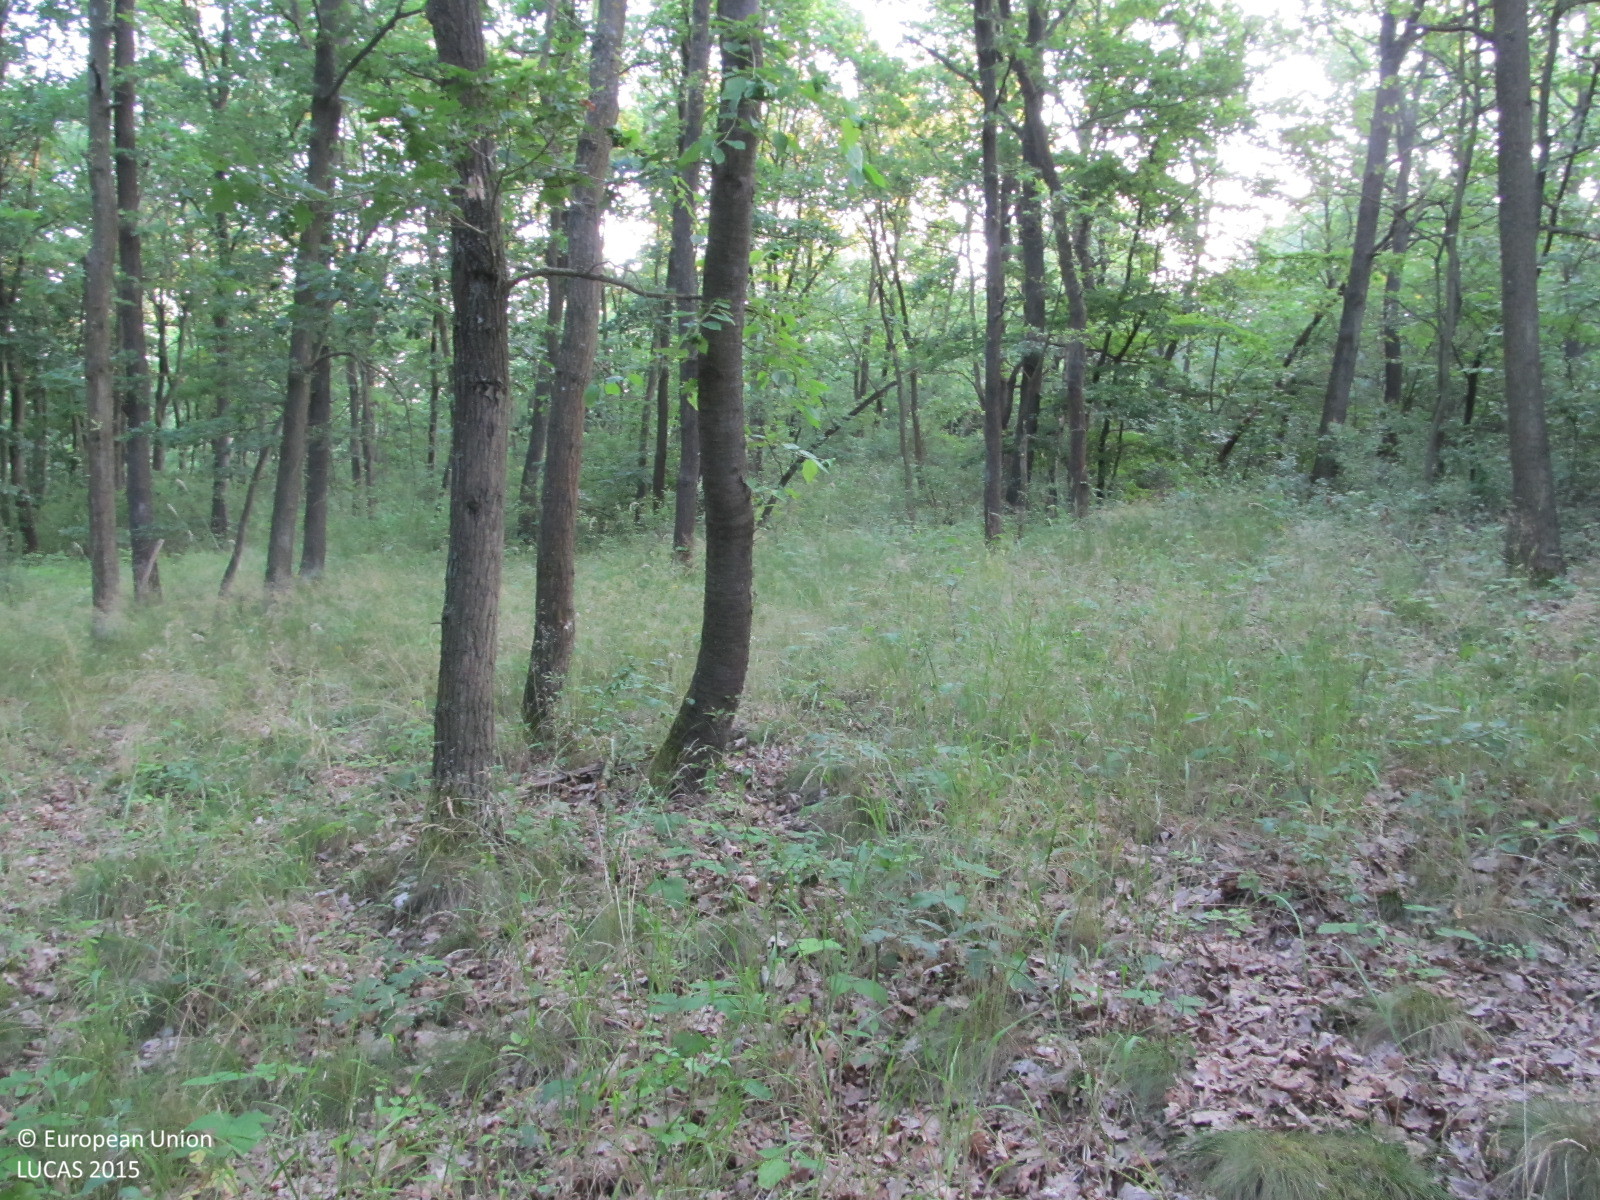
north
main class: Woodland
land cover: Broadleaved woodland
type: mesophytic deciduous forest
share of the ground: > 75 %
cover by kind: broadleaved forest trees 75 %, shrubs 10 %, herbaceous plants 10 %, unconsolidated bare surface 5 %
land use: Forestry
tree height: > 5 m
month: July
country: AT
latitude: 48.7184
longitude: 15.8351
